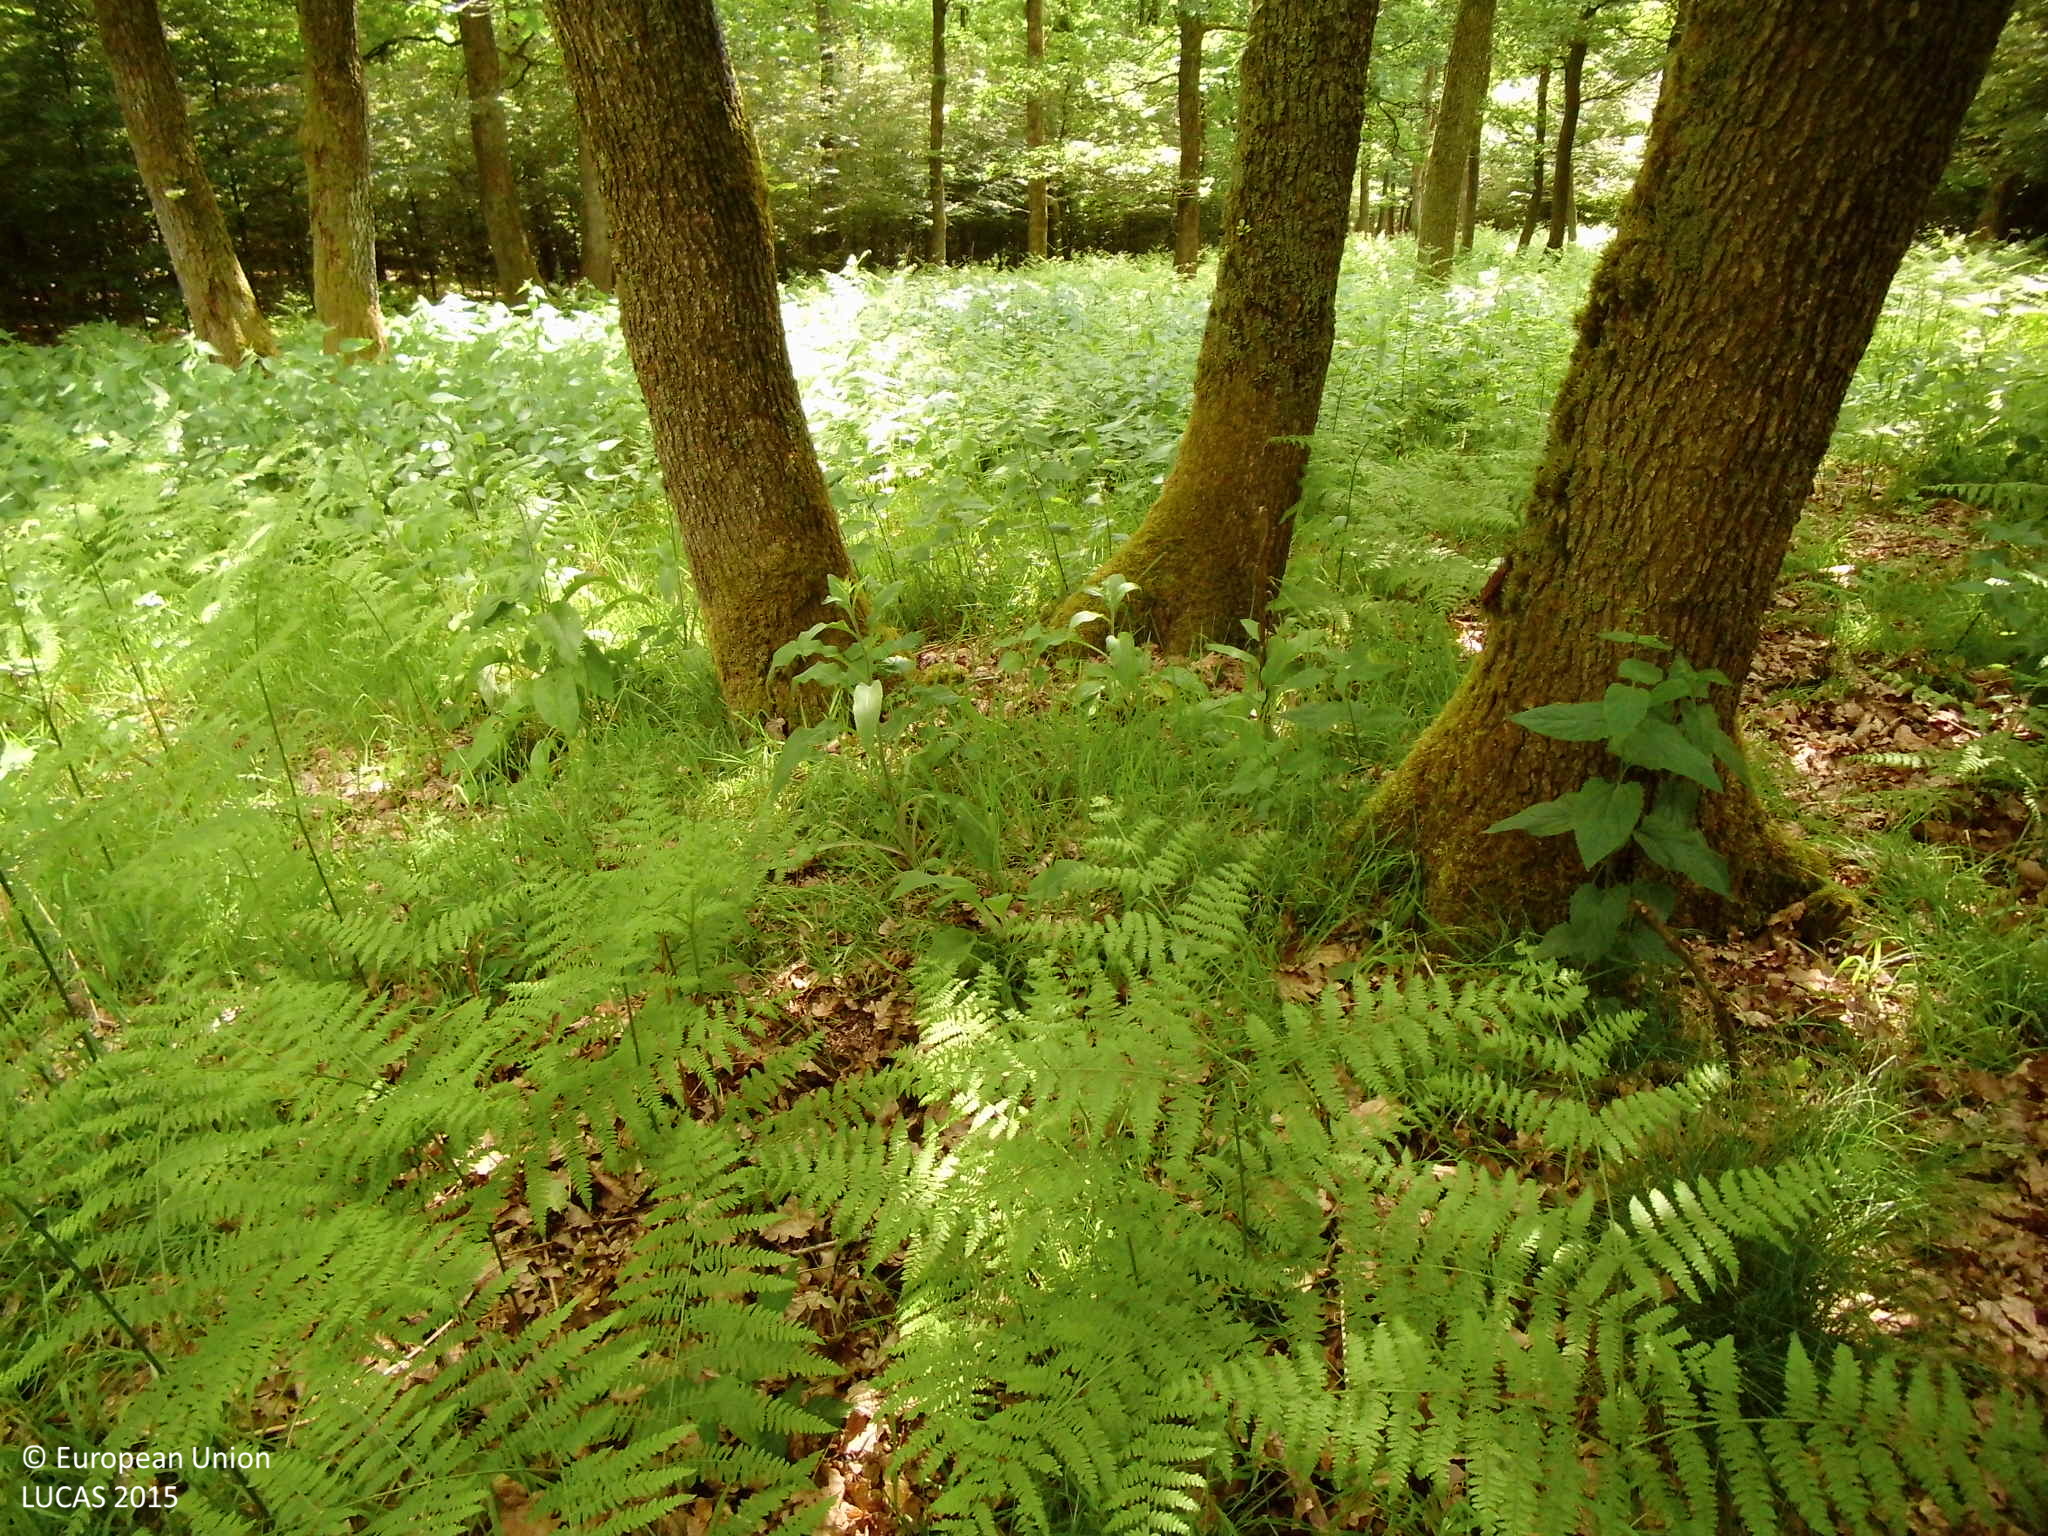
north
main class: Woodland
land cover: Broadleaved woodland
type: mesophytic deciduous forest
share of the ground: > 75 %
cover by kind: broadleaved forest trees 80 %, herbaceous plants 20 %
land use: Forestry
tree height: > 5 m
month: June
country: DE
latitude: 50.7981
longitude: 8.1133
